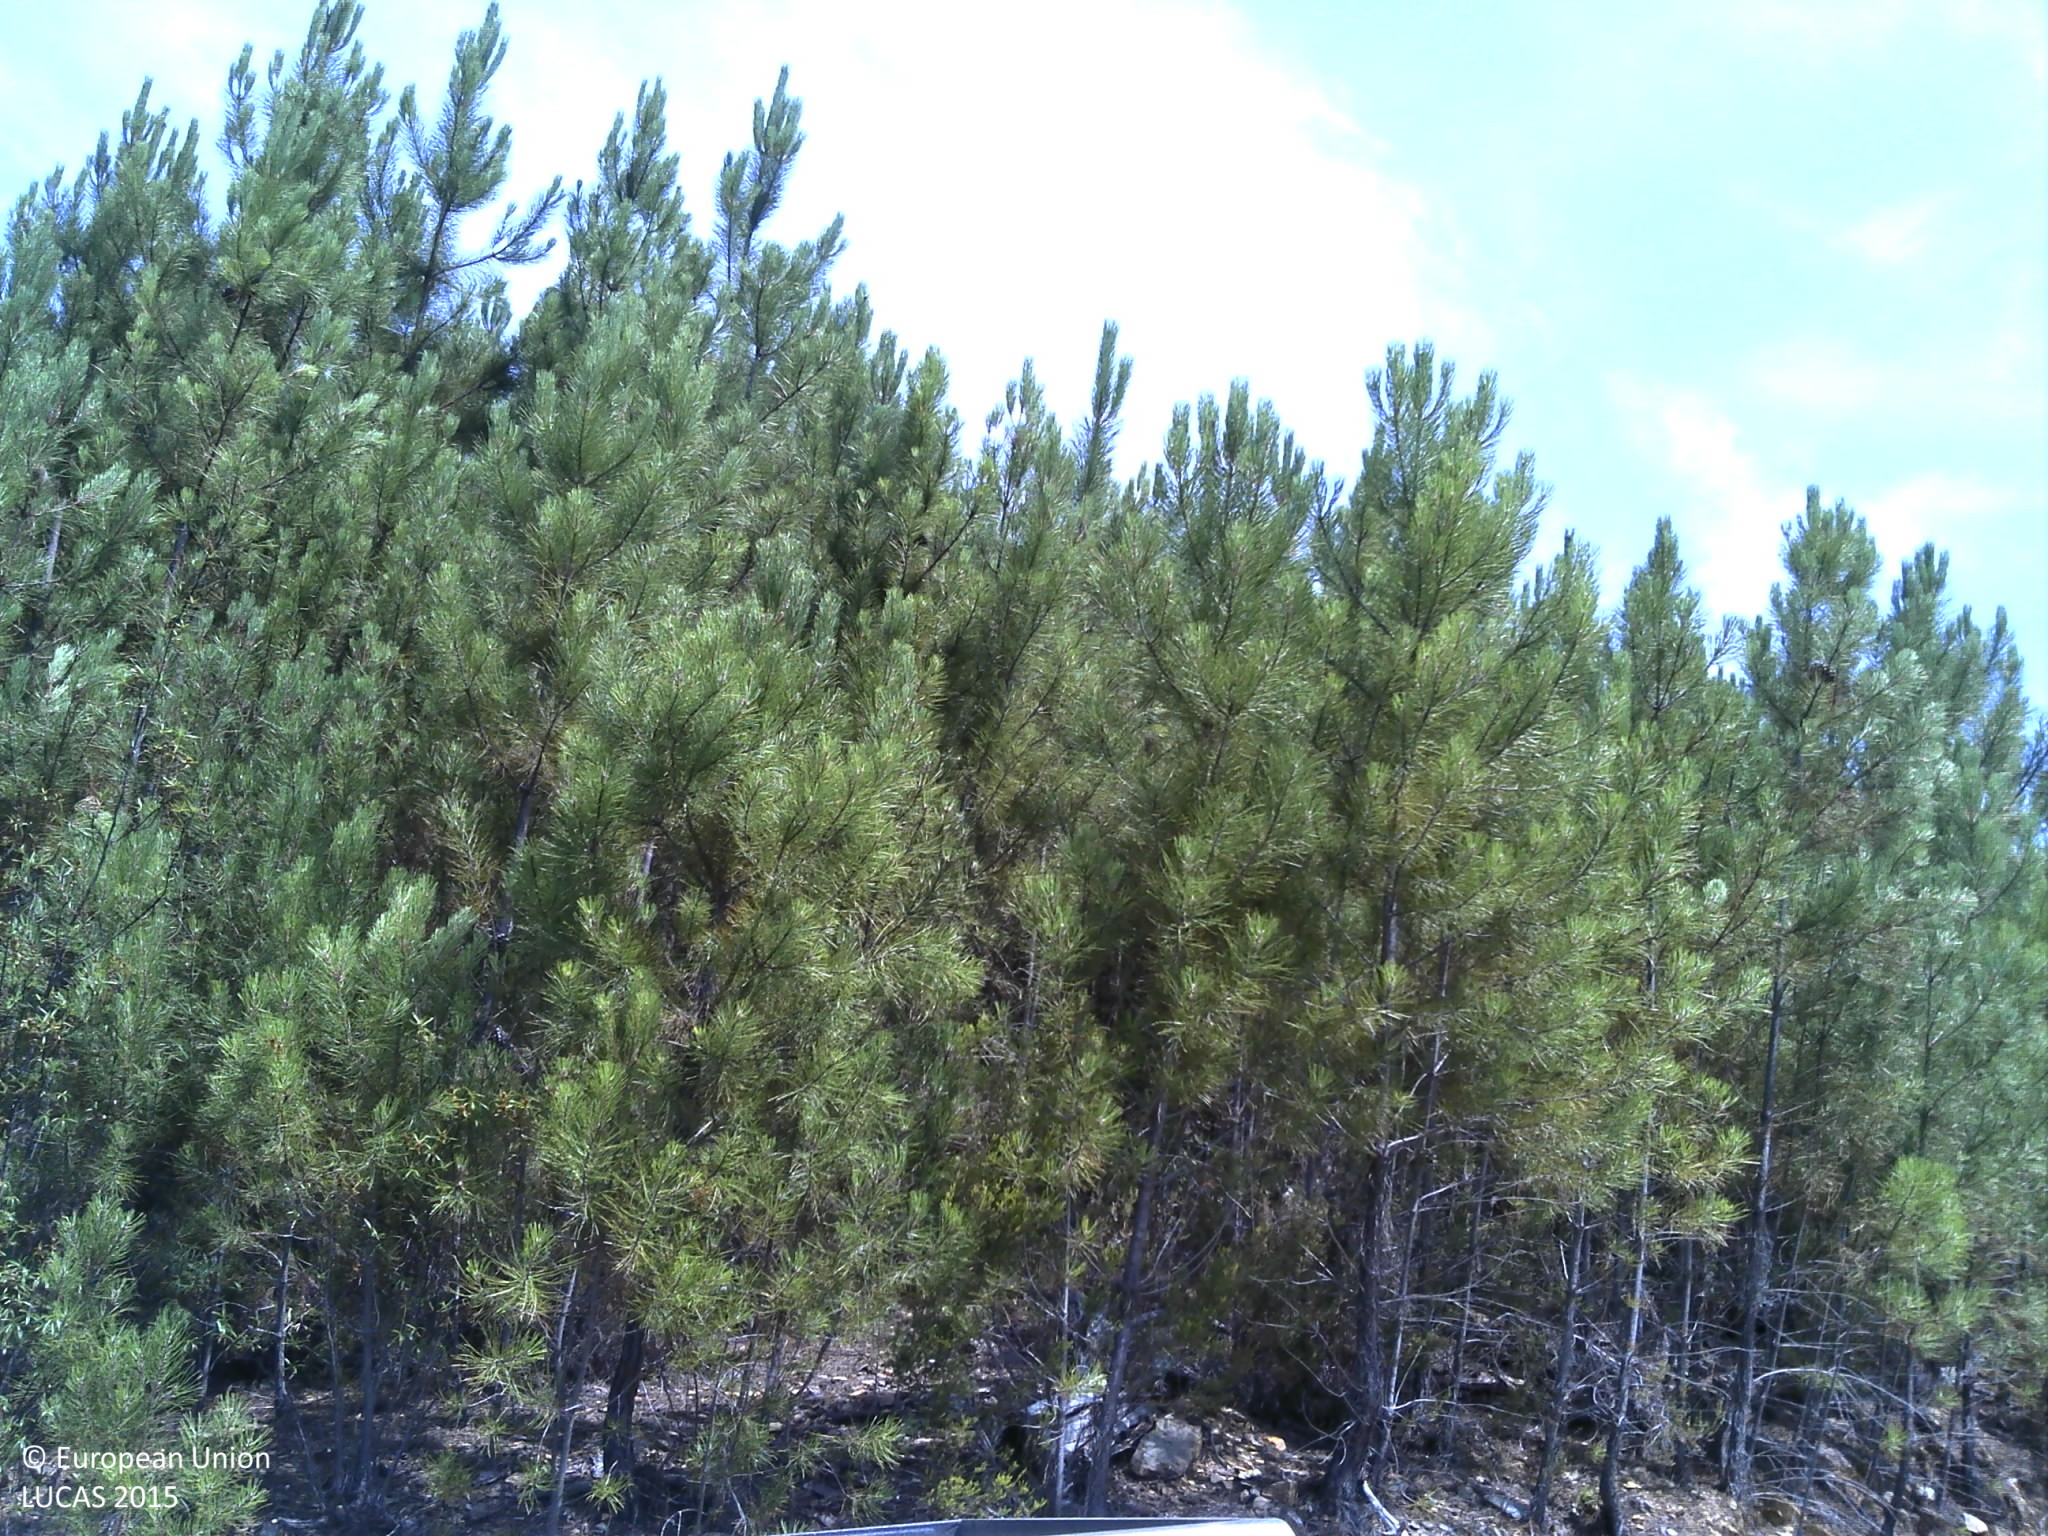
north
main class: Woodland
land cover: Pine dominated coniferous woodland
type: coniferous forest of the mediterranean region
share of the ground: 25 - 50 %
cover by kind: shrubs 50 %, coniferous forest trees 30 %, unconsolidated bare surface 20 %
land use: Forestry
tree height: < 5 m
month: July
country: PT
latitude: 39.8417
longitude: -7.8121
